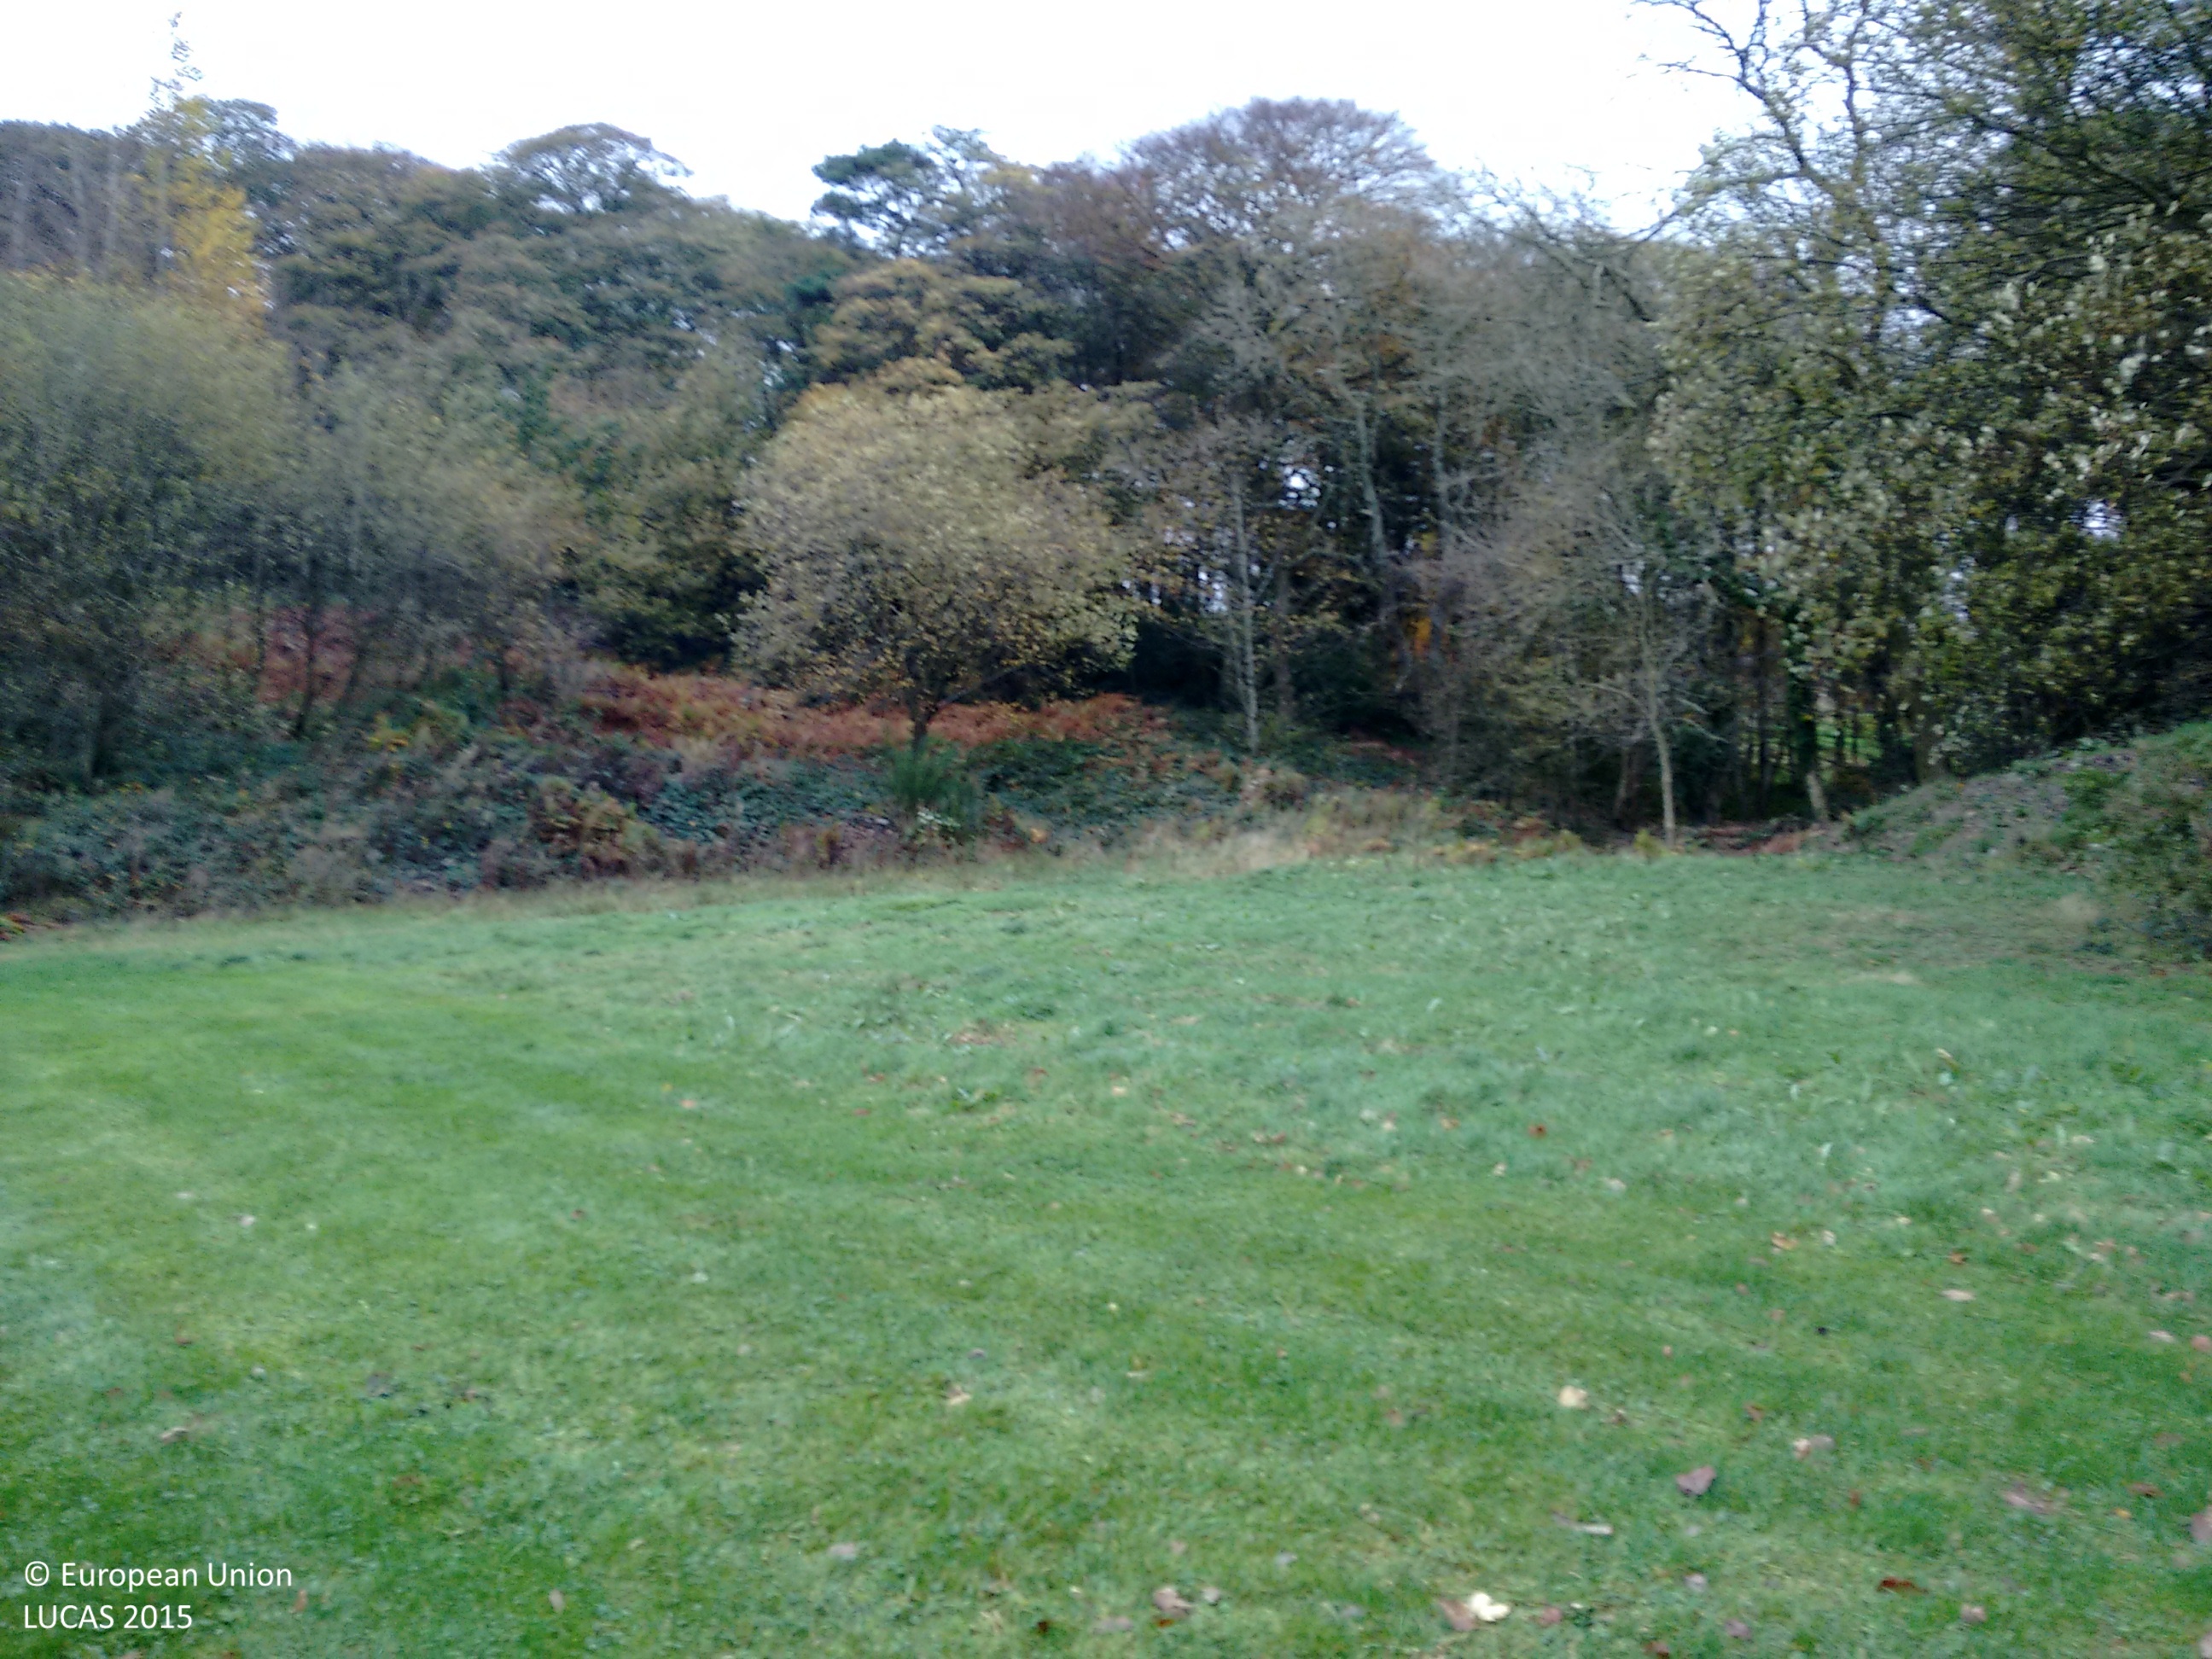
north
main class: Grassland
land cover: Grassland without tree/shrub cover
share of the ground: > 75 %
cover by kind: herbaceous plants 100 %
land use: Sport
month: November
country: GB
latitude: 54.2788
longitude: -3.2083
